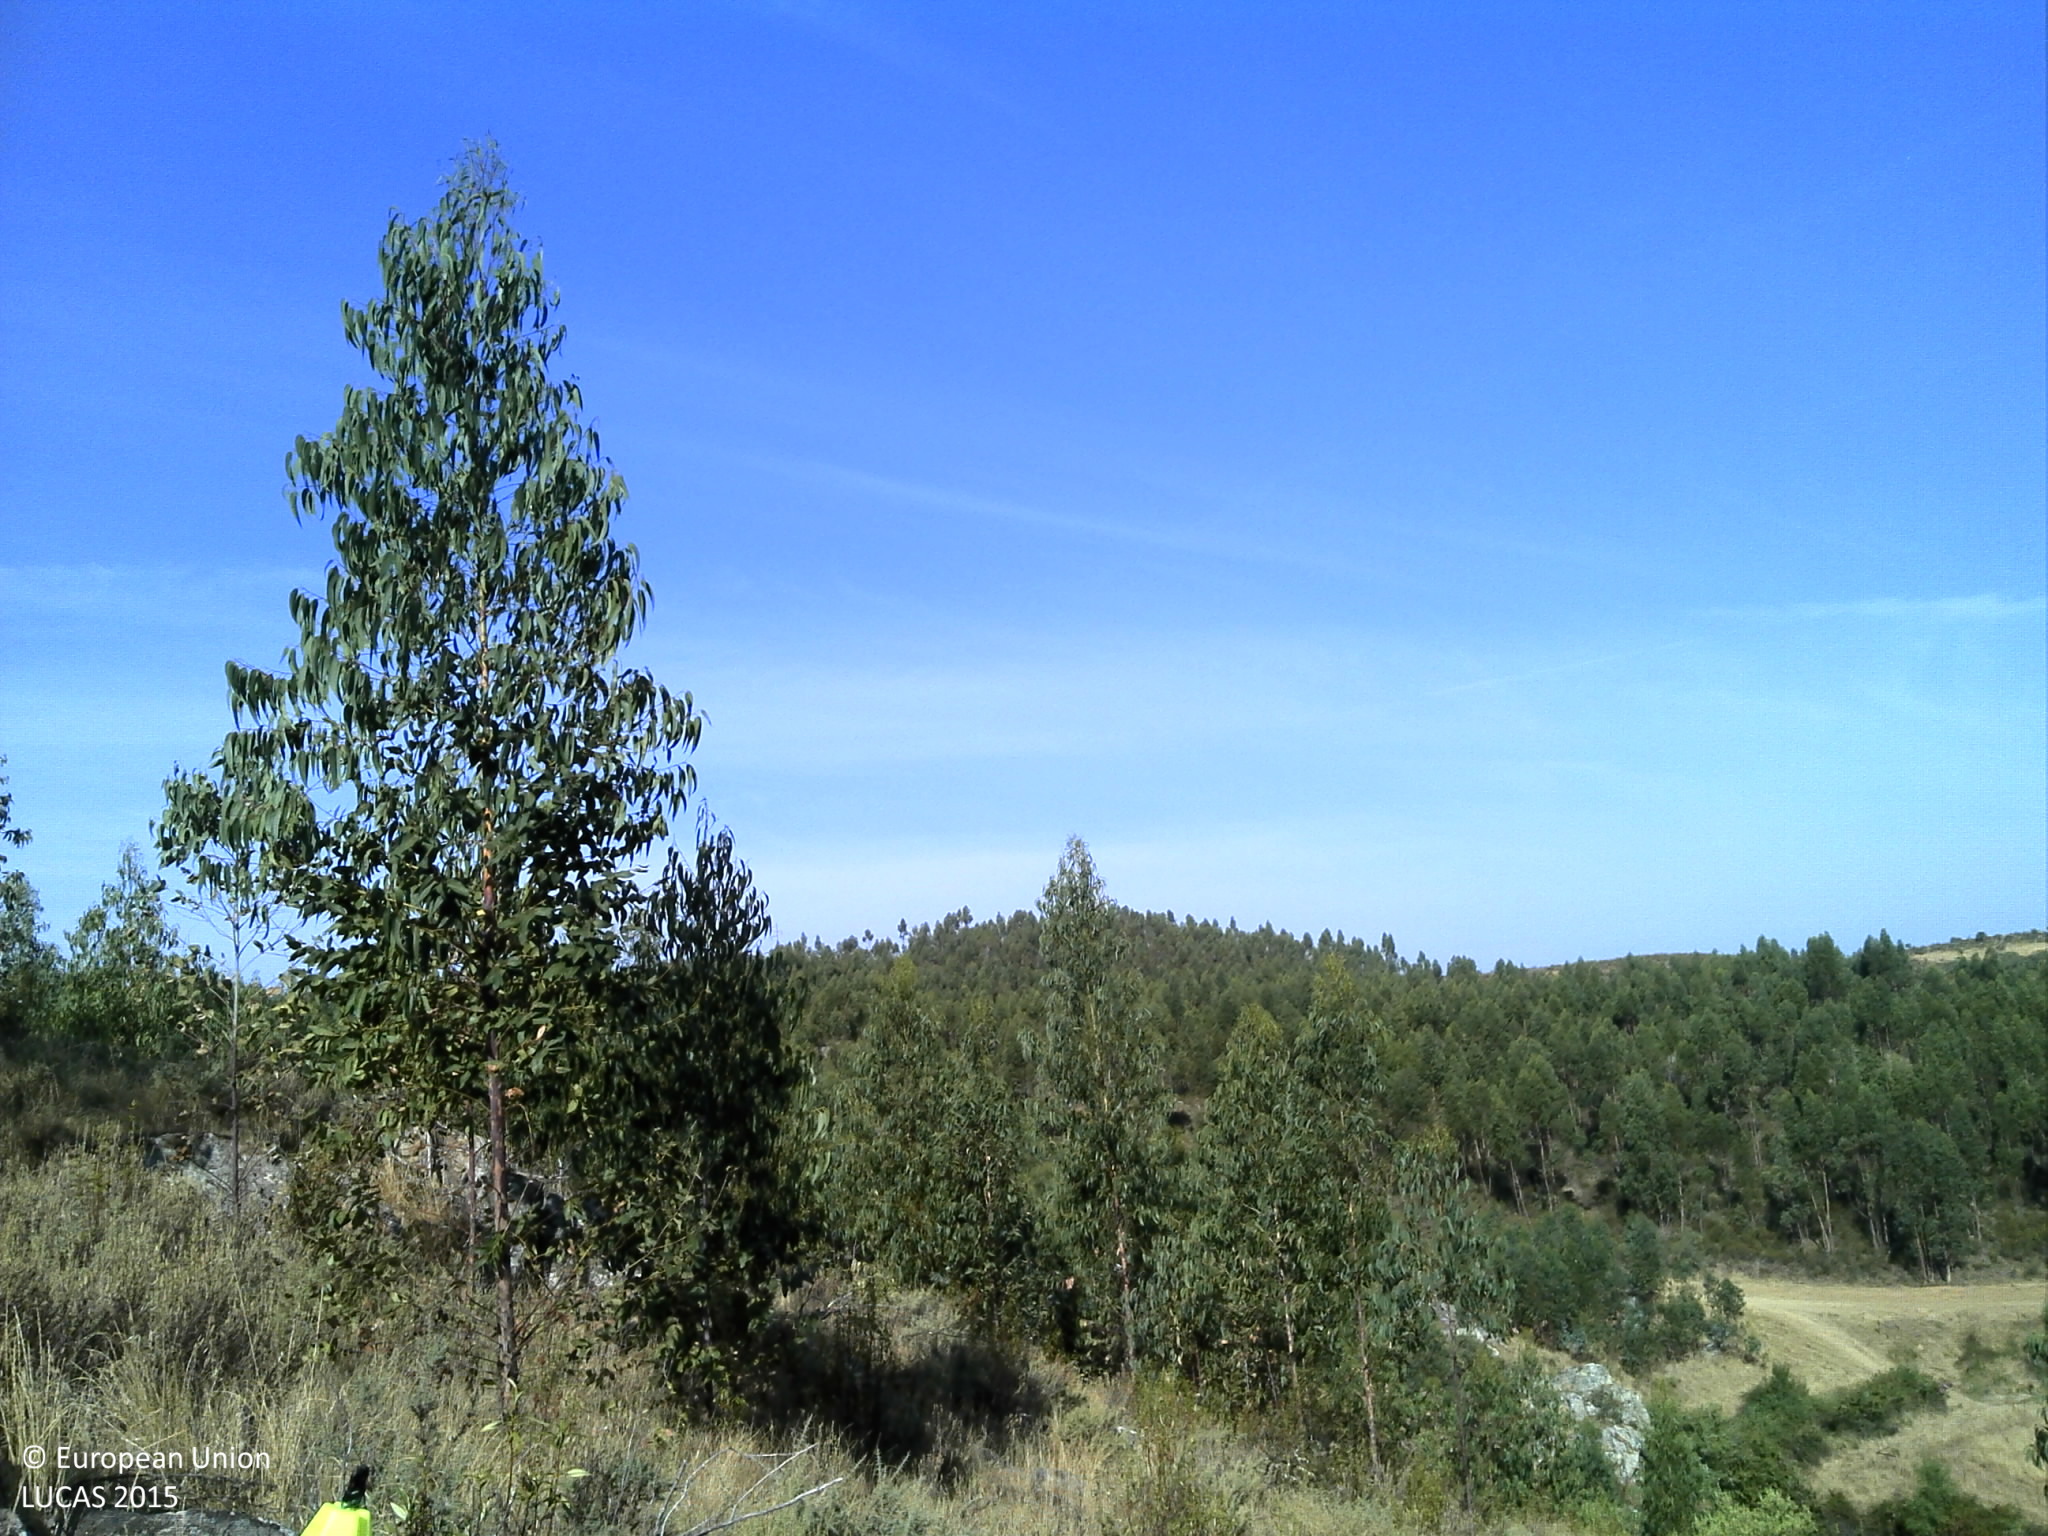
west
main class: Woodland
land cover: Broadleaved woodland
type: exotic forest
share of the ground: 10 - 25 %
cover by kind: broadleaved forest trees 20 %, shrubs 20 %, herbaceous plants 20 %, consolidated bare surface 20 %, unconsolidated bare surface 20 %
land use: Forestry
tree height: > 5 m
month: July
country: PT
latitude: 38.6331
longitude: -7.4567
